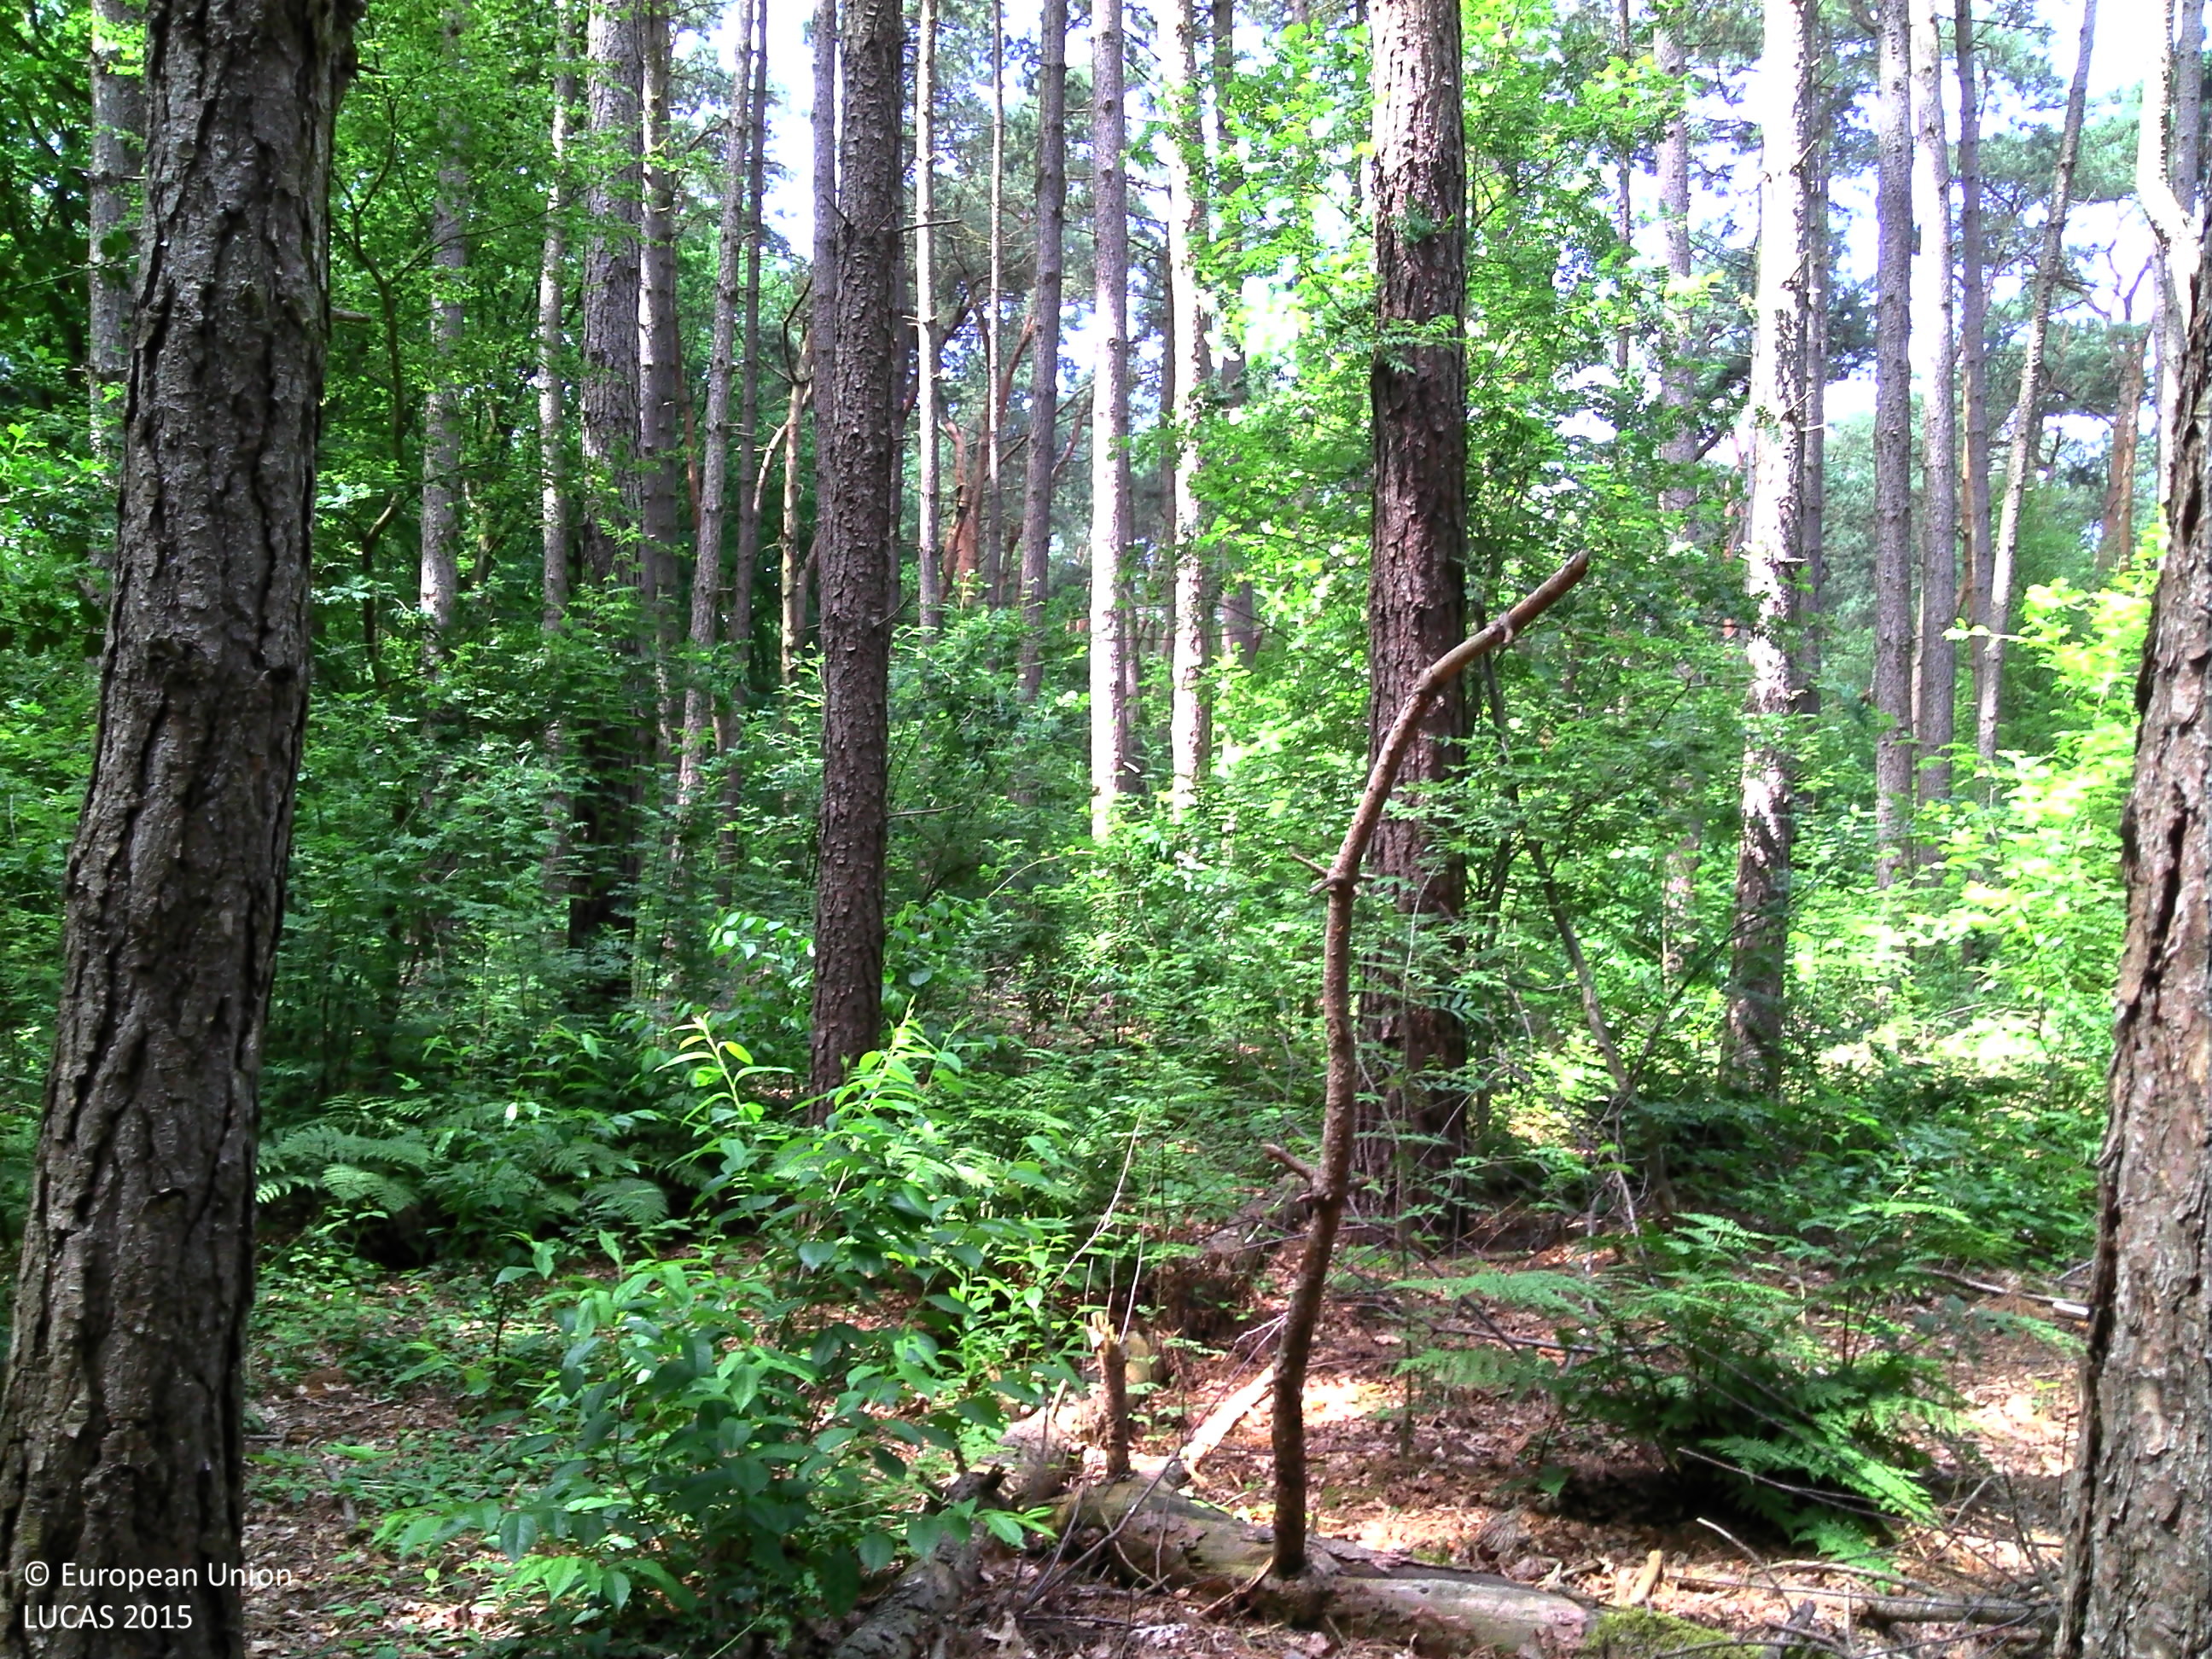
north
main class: Woodland
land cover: Pine dominated mixed woodland
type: exotic forest
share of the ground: > 75 %
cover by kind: coniferous forest trees 60 %, broadleaved forest trees 40 %
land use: Forestry
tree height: > 5 m
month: June
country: BE
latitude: 50.9310
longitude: 5.6872
